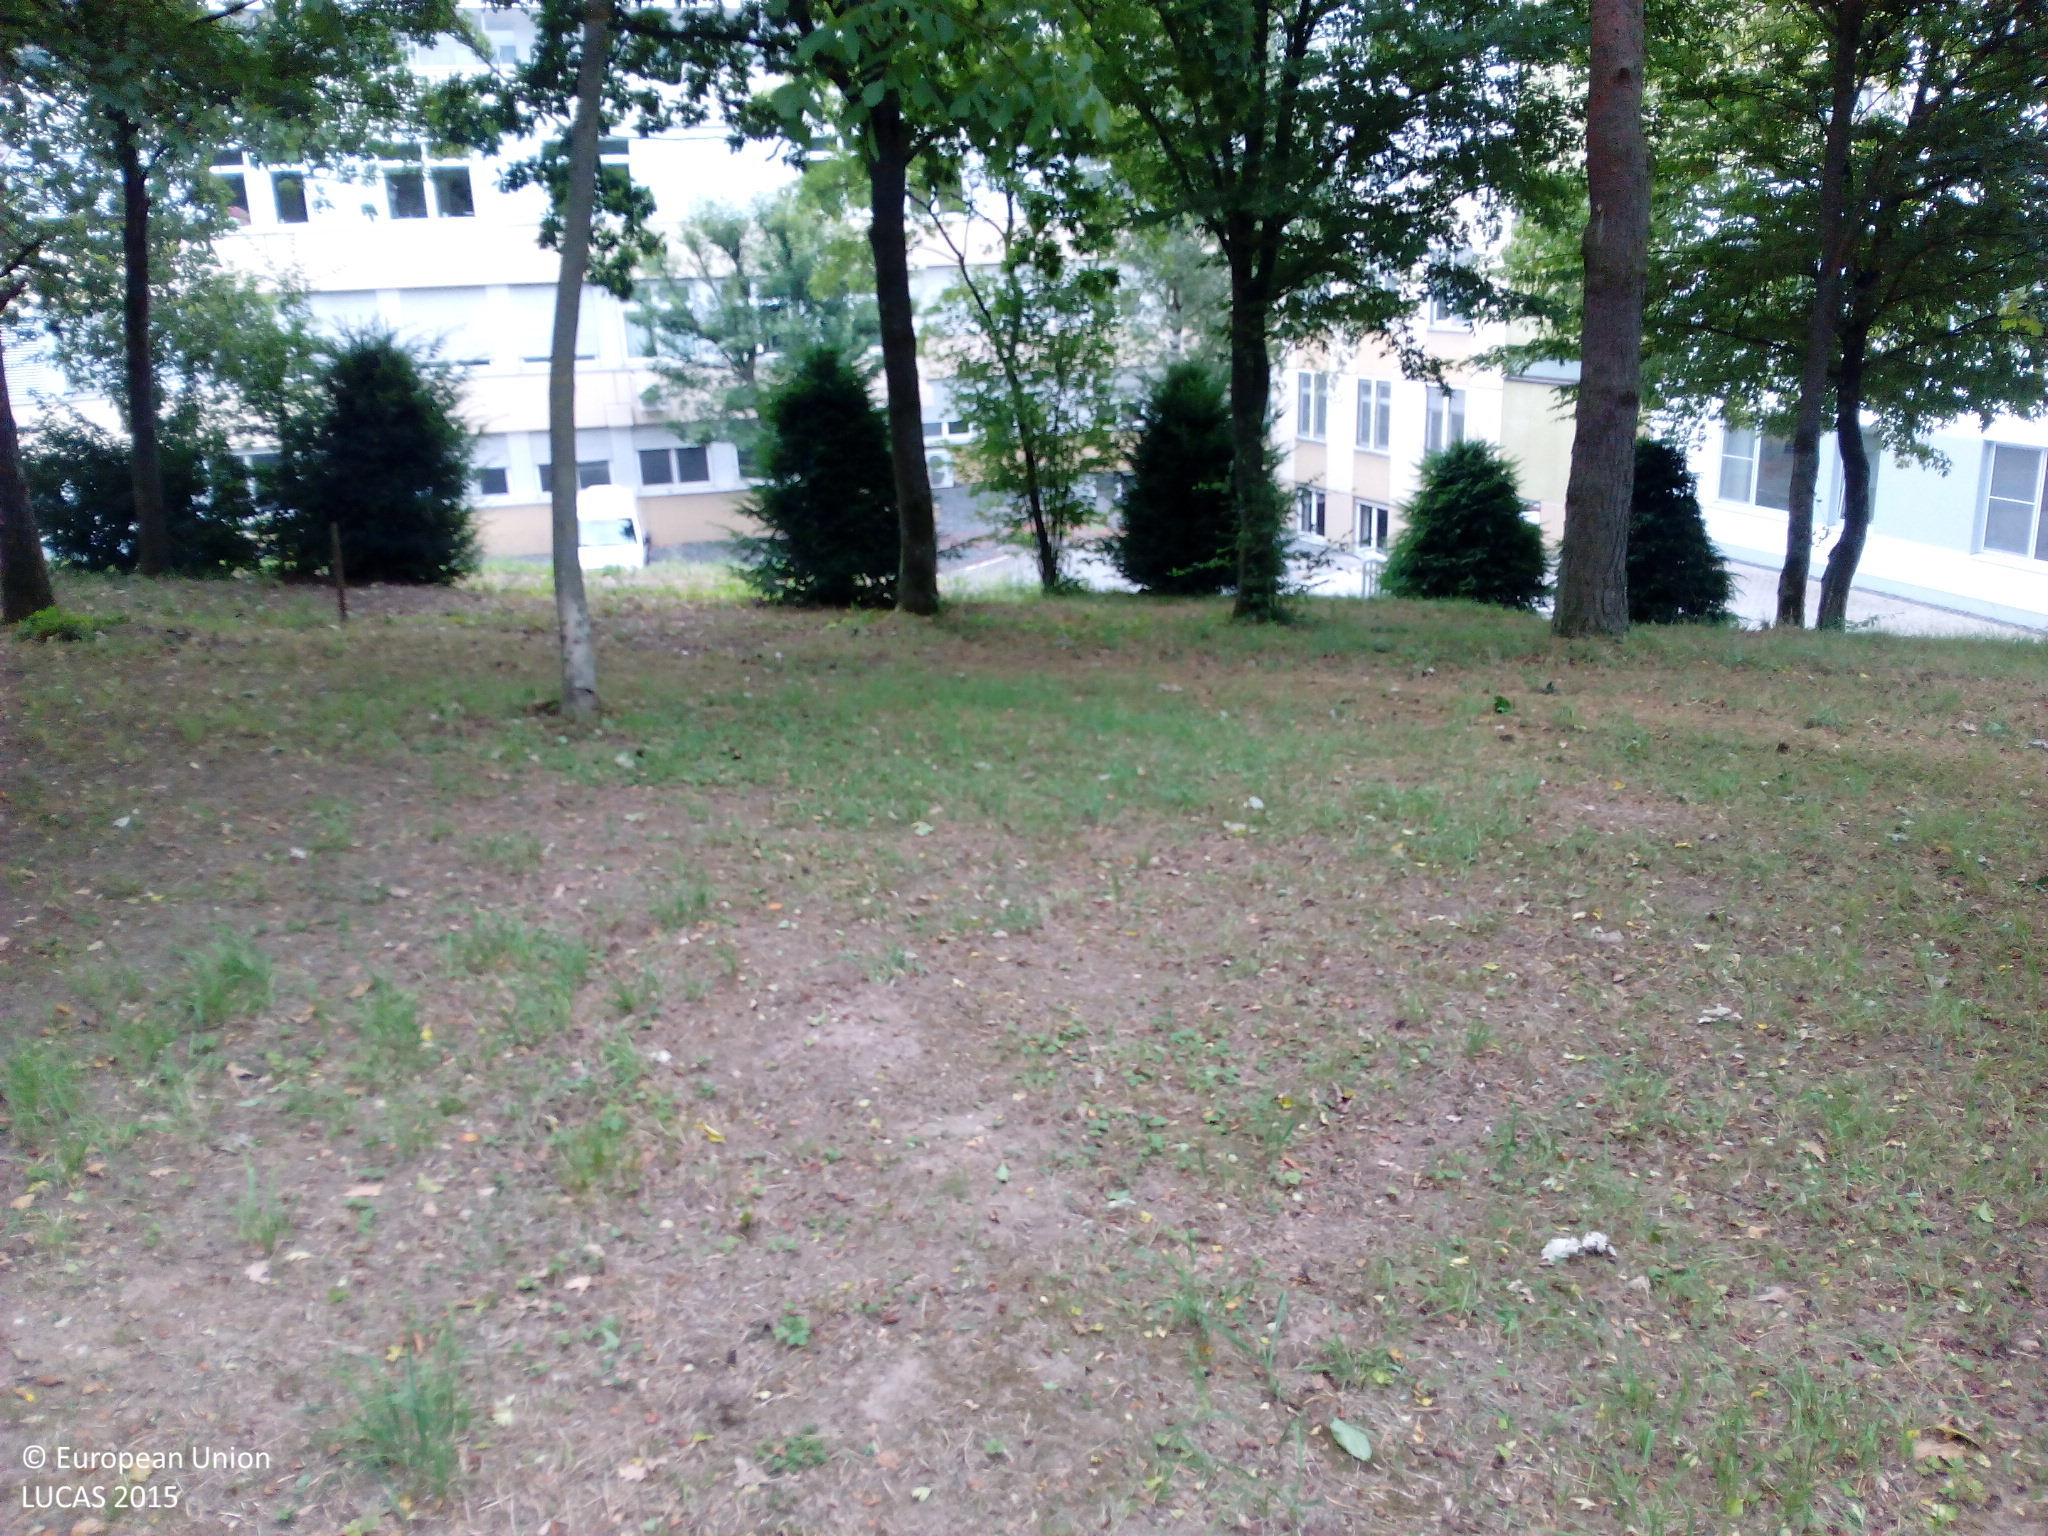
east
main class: Woodland
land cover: Other mixed woodland
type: hemiboreal forest and nemoral coniferous forest and mixed broadleaved-coniferous forest
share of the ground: > 75 %
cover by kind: broadleaved forest trees 75 %, coniferous forest trees 25 %
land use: Community services
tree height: > 5 m
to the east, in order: Other mixed woodland; Artificial constructions in urban areas; Vineyards; Spontaneously vegetated surfaces
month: July
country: DE
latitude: 50.0231
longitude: 7.1667
